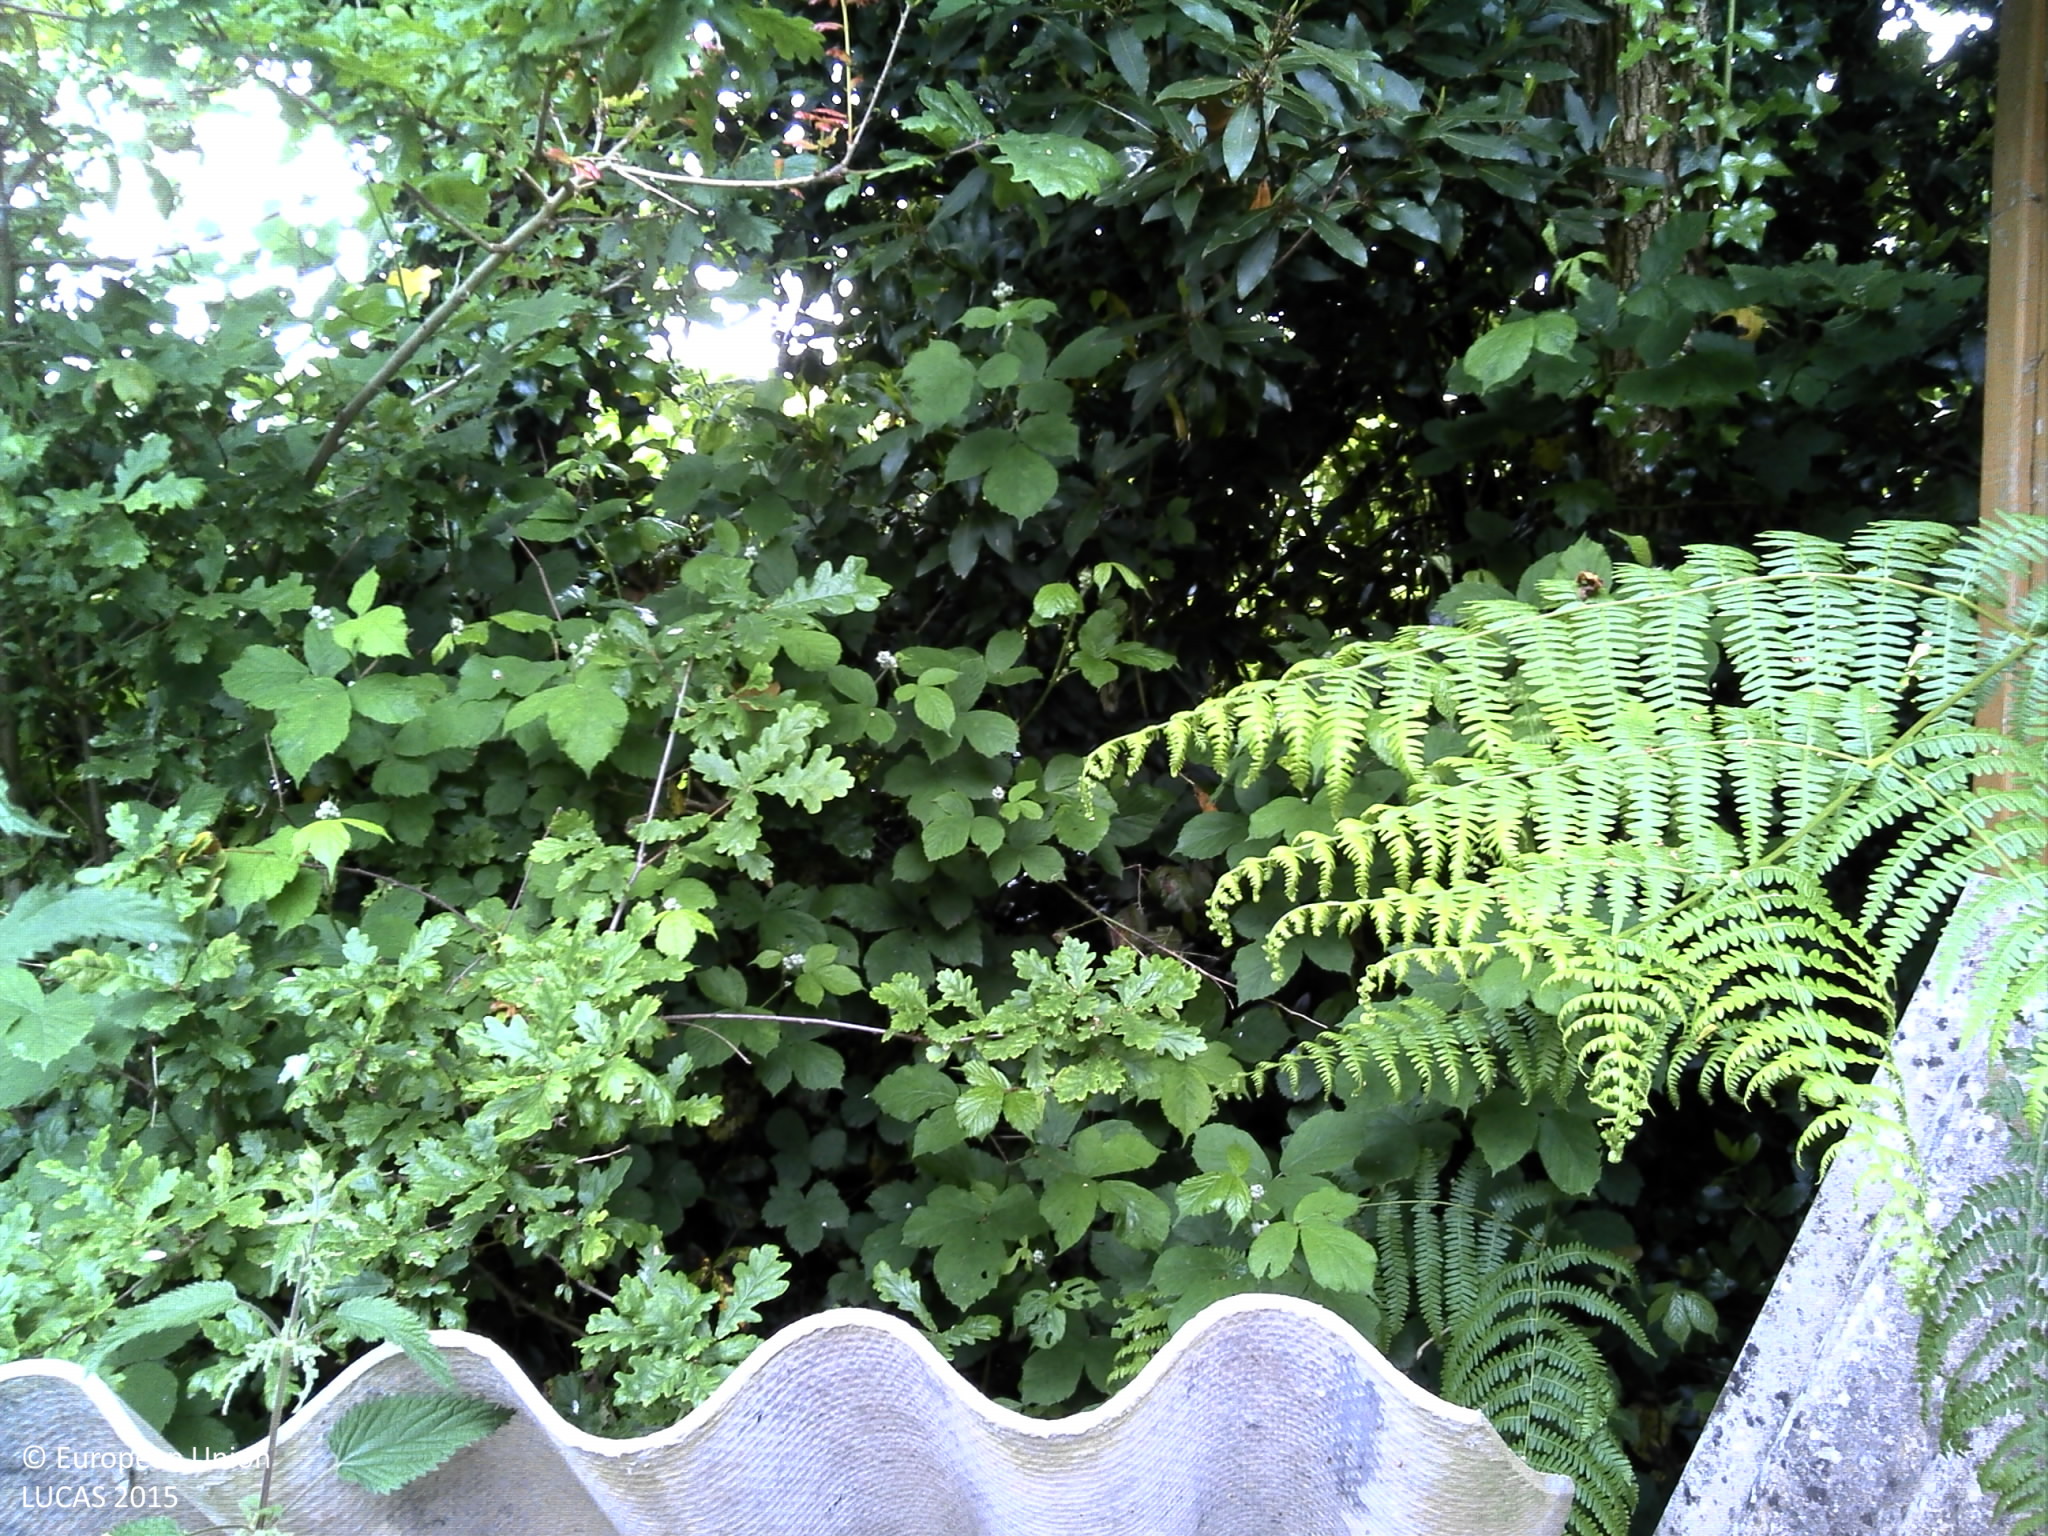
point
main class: Grassland
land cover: Grassland without tree/shrub cover
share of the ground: > 75 %
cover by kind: herbaceous plants 100 %
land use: Residential
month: June
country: FR
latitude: 47.9399
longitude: -3.6127
